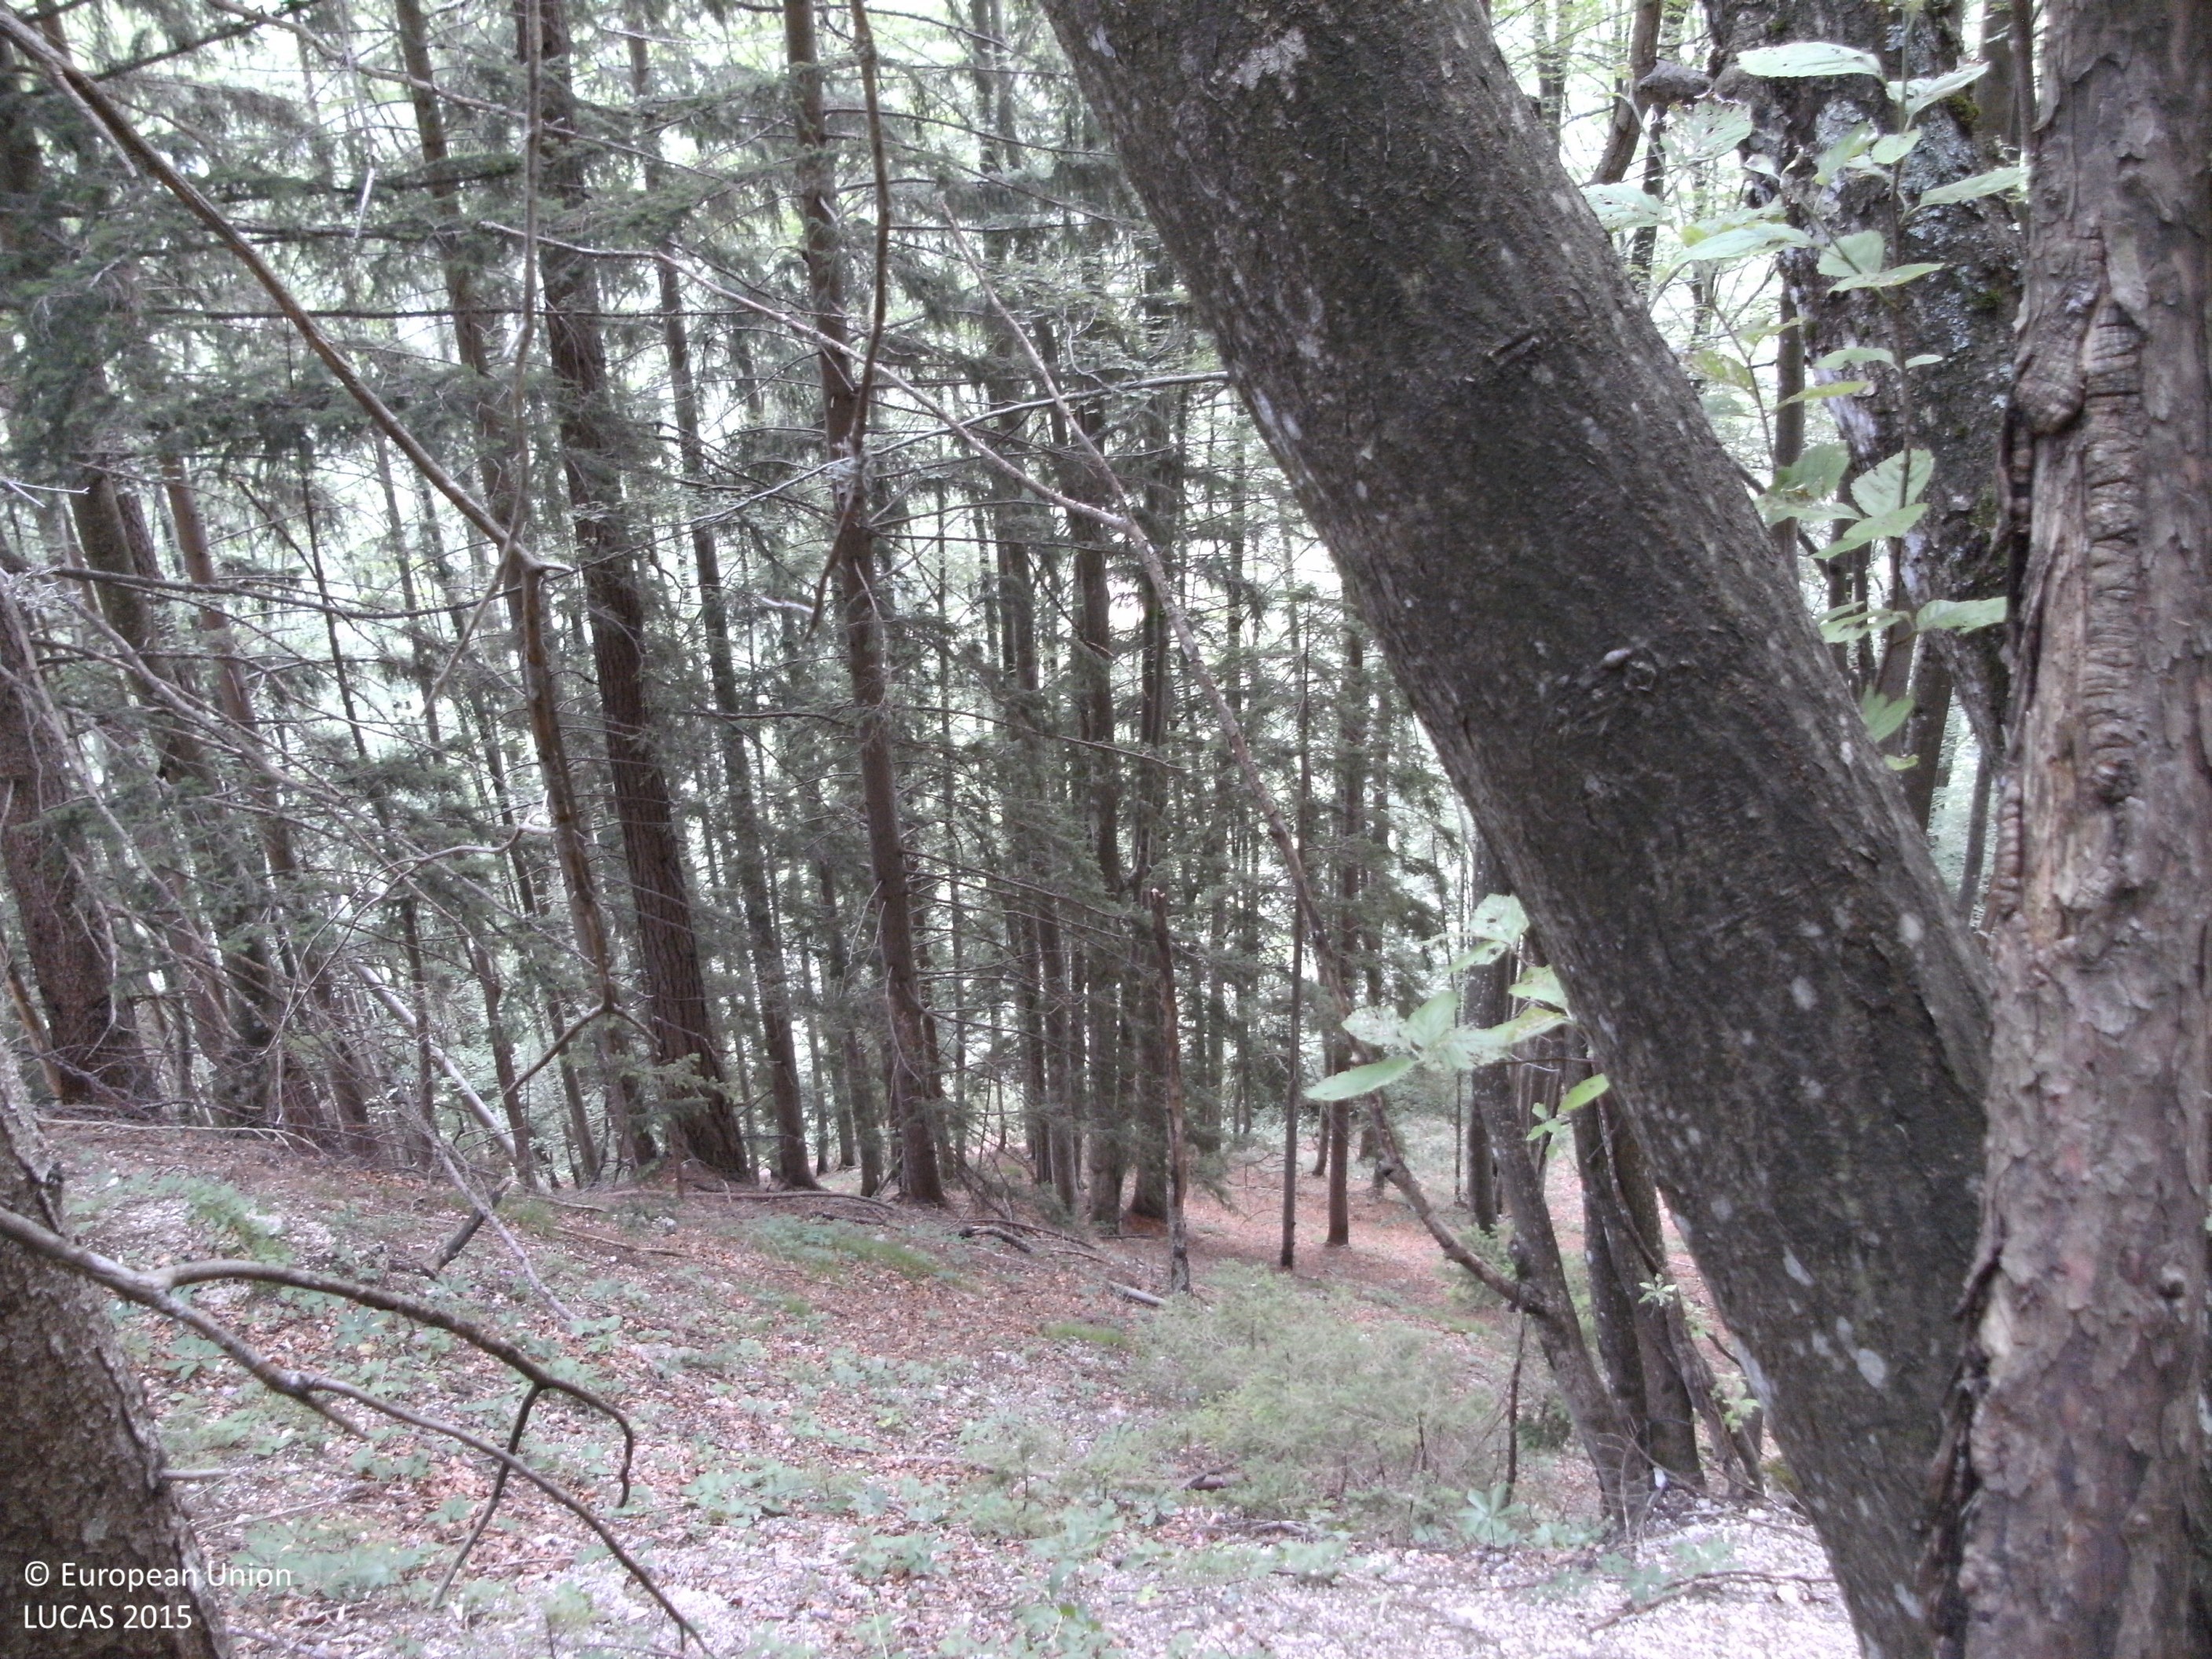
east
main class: Woodland
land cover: Other mixed woodland
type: mountainous beech forest
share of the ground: > 75 %
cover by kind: broadleaved forest trees 50 %, coniferous forest trees 45 %, consolidated bare surface 5 %
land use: Forestry
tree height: > 5 m
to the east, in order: Other mixed woodland; Broadleaved woodland; Other coniferous woodland; Spruce dominated mixed woodland; Spruce dominated coniferous woodland
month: July
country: AT
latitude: 46.3982
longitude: 14.5623
